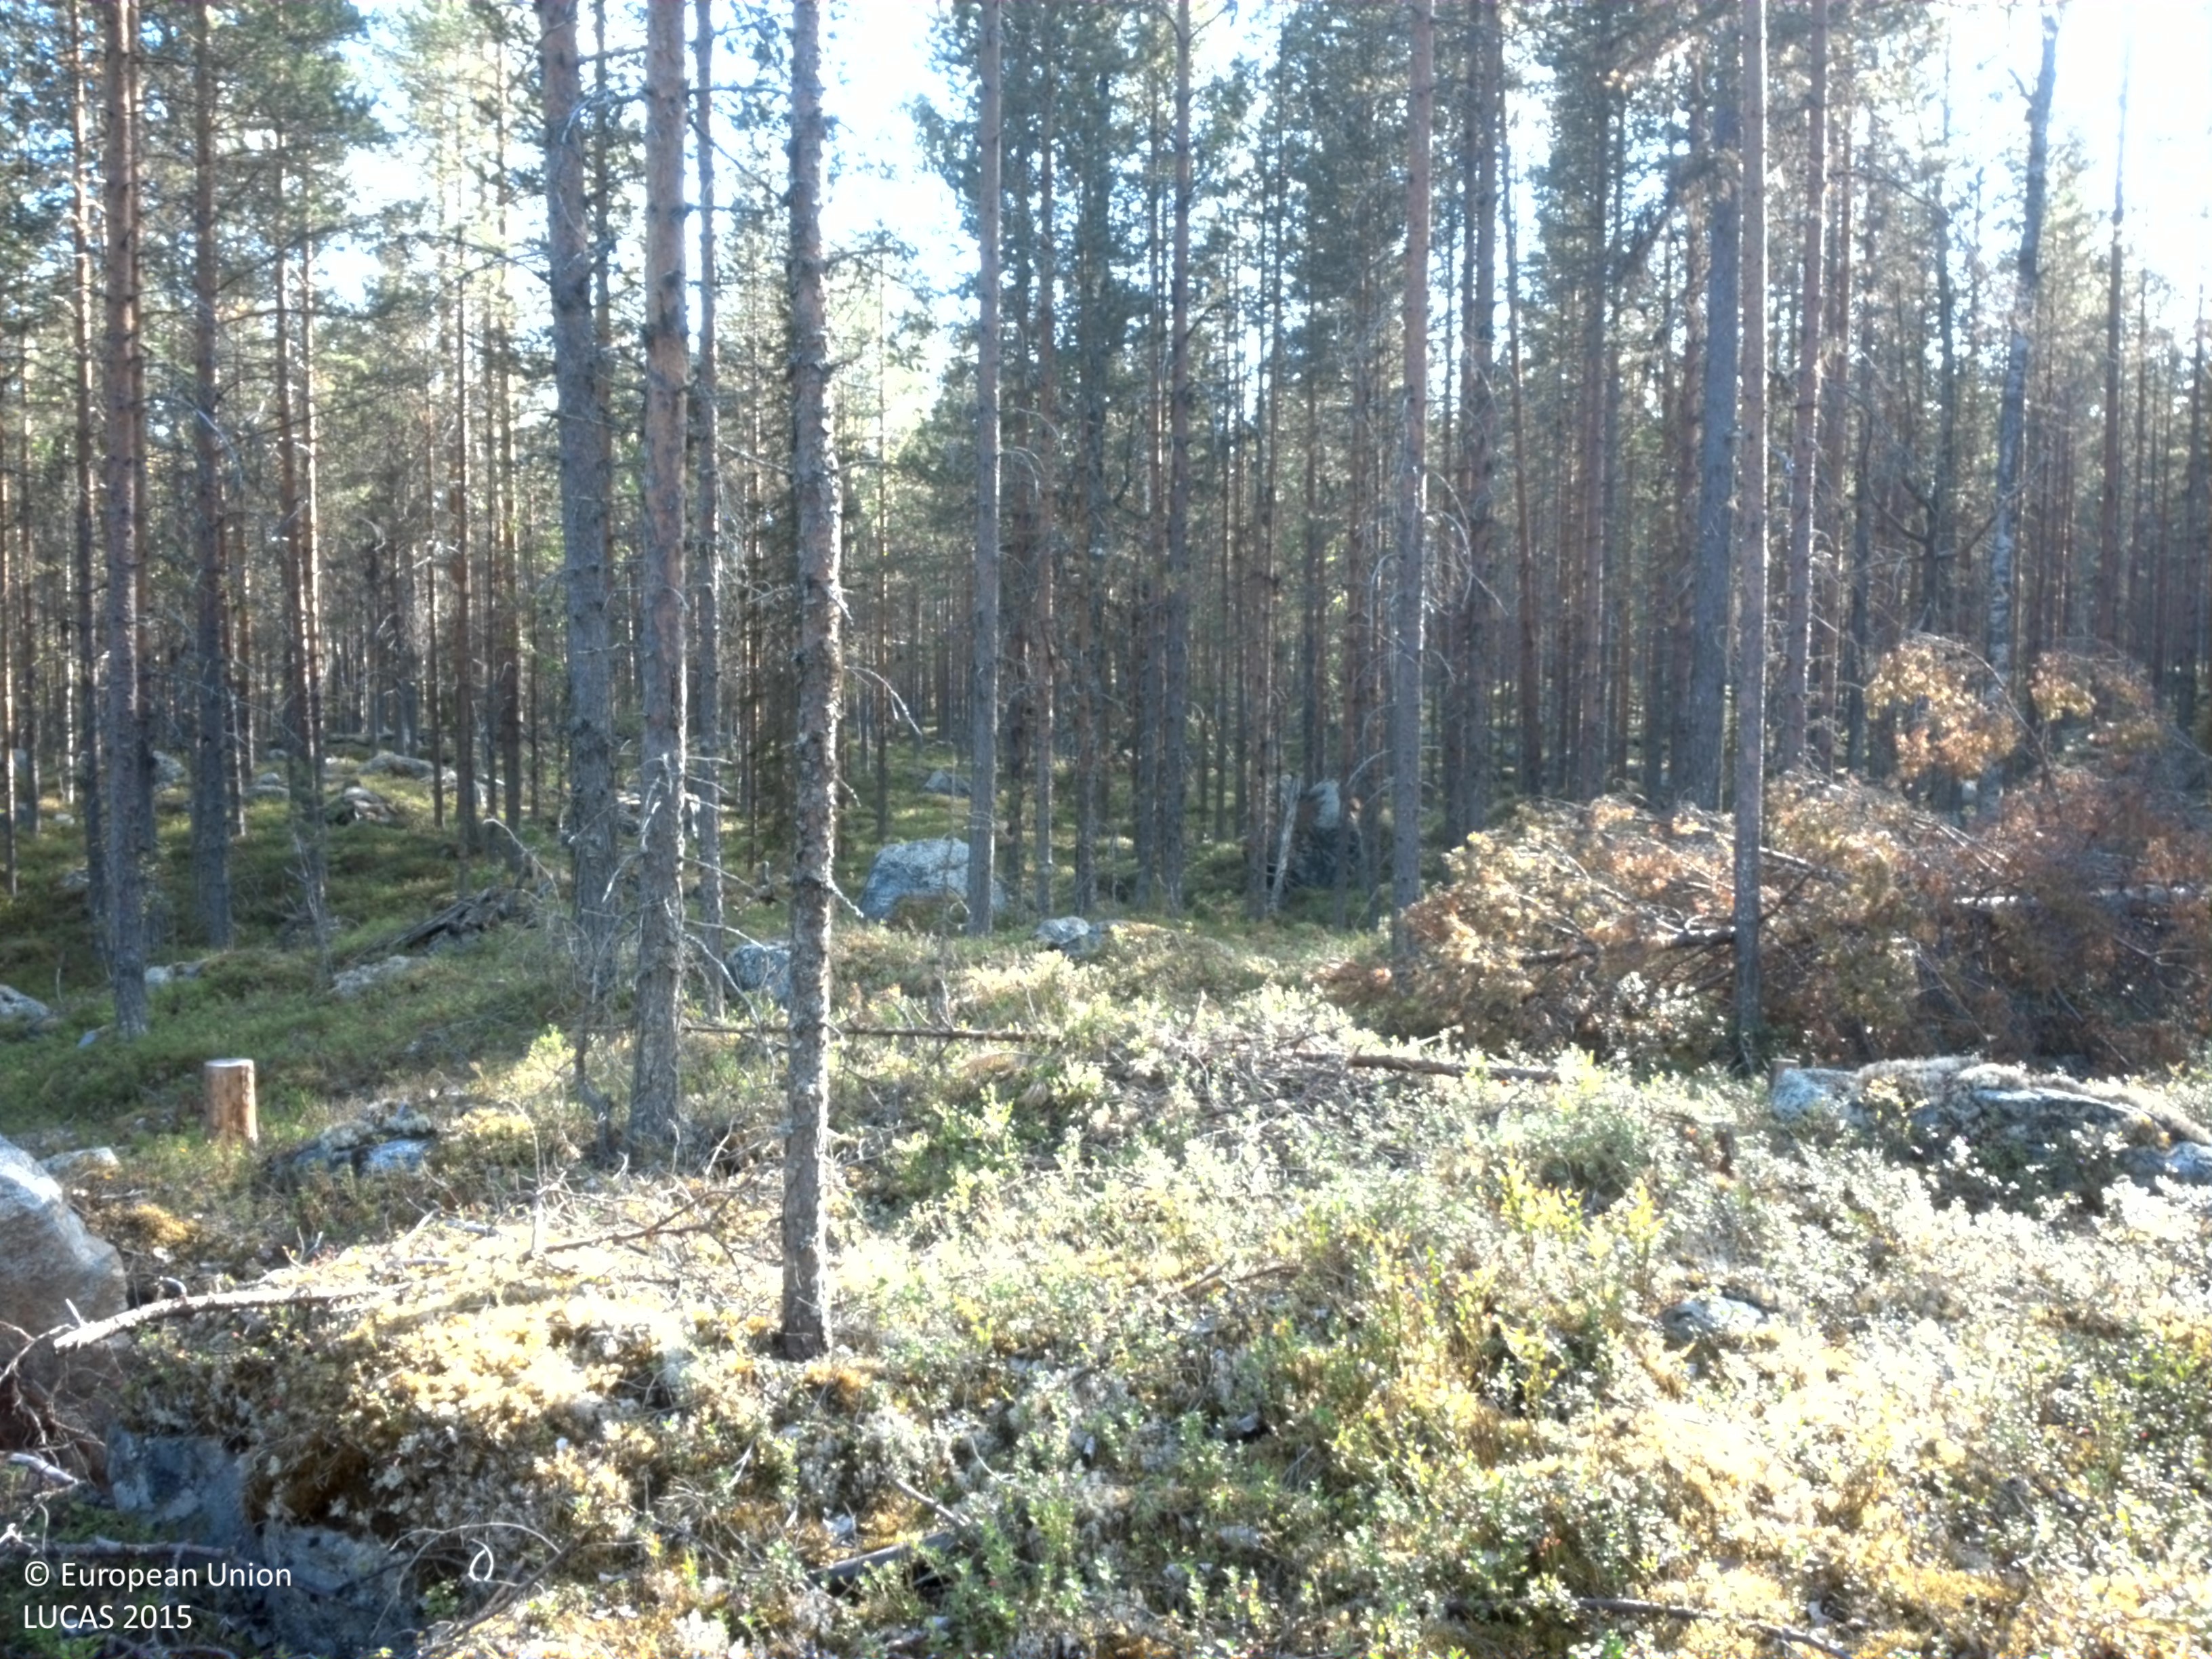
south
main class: Woodland
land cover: Pine dominated coniferous woodland
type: boreal forest
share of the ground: 50 - 75 %
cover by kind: coniferous forest trees 55 %, shrubs 35 %, lichens and mosses 10 %
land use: Forestry
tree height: > 5 m
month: August
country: SE
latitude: 64.5653
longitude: 18.9214
